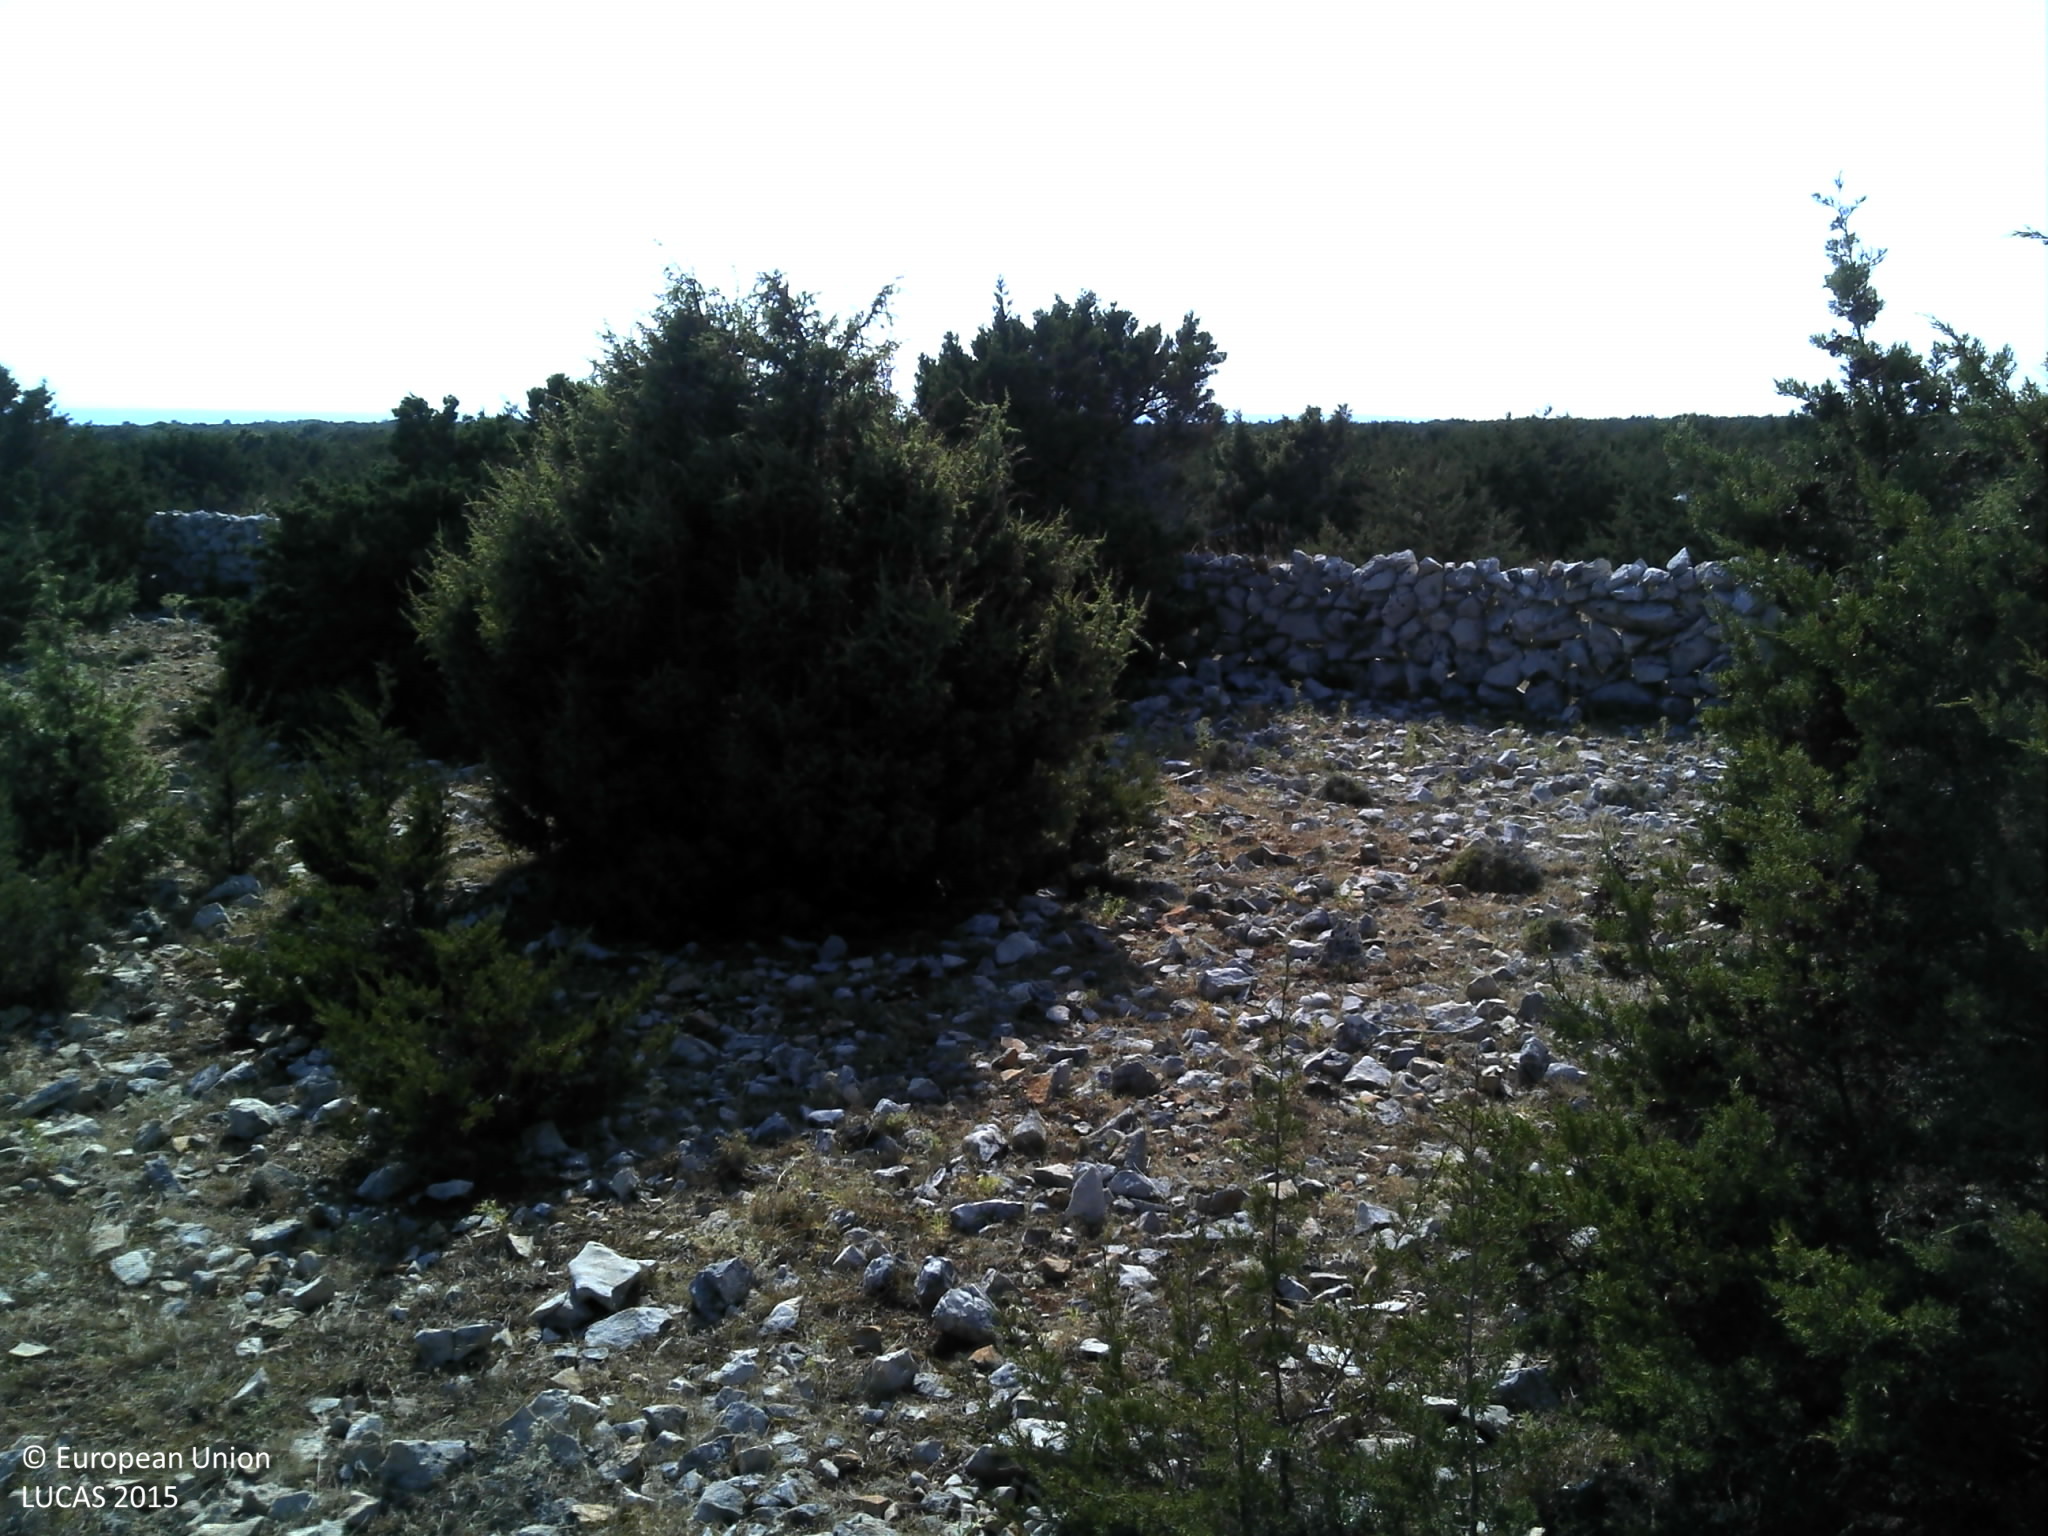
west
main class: Shrubland
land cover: Shrubland with sparse tree cover
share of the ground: 25 - 50 %
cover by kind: shrubs 40 %, consolidated bare surface 20 %, unconsolidated bare surface 20 %, herbaceous plants 15 %, coniferous forest trees 5 %
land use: Semi-natural and natural areas not in use
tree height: < 5 m
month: July
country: HR
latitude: 44.4081
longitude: 15.0534
